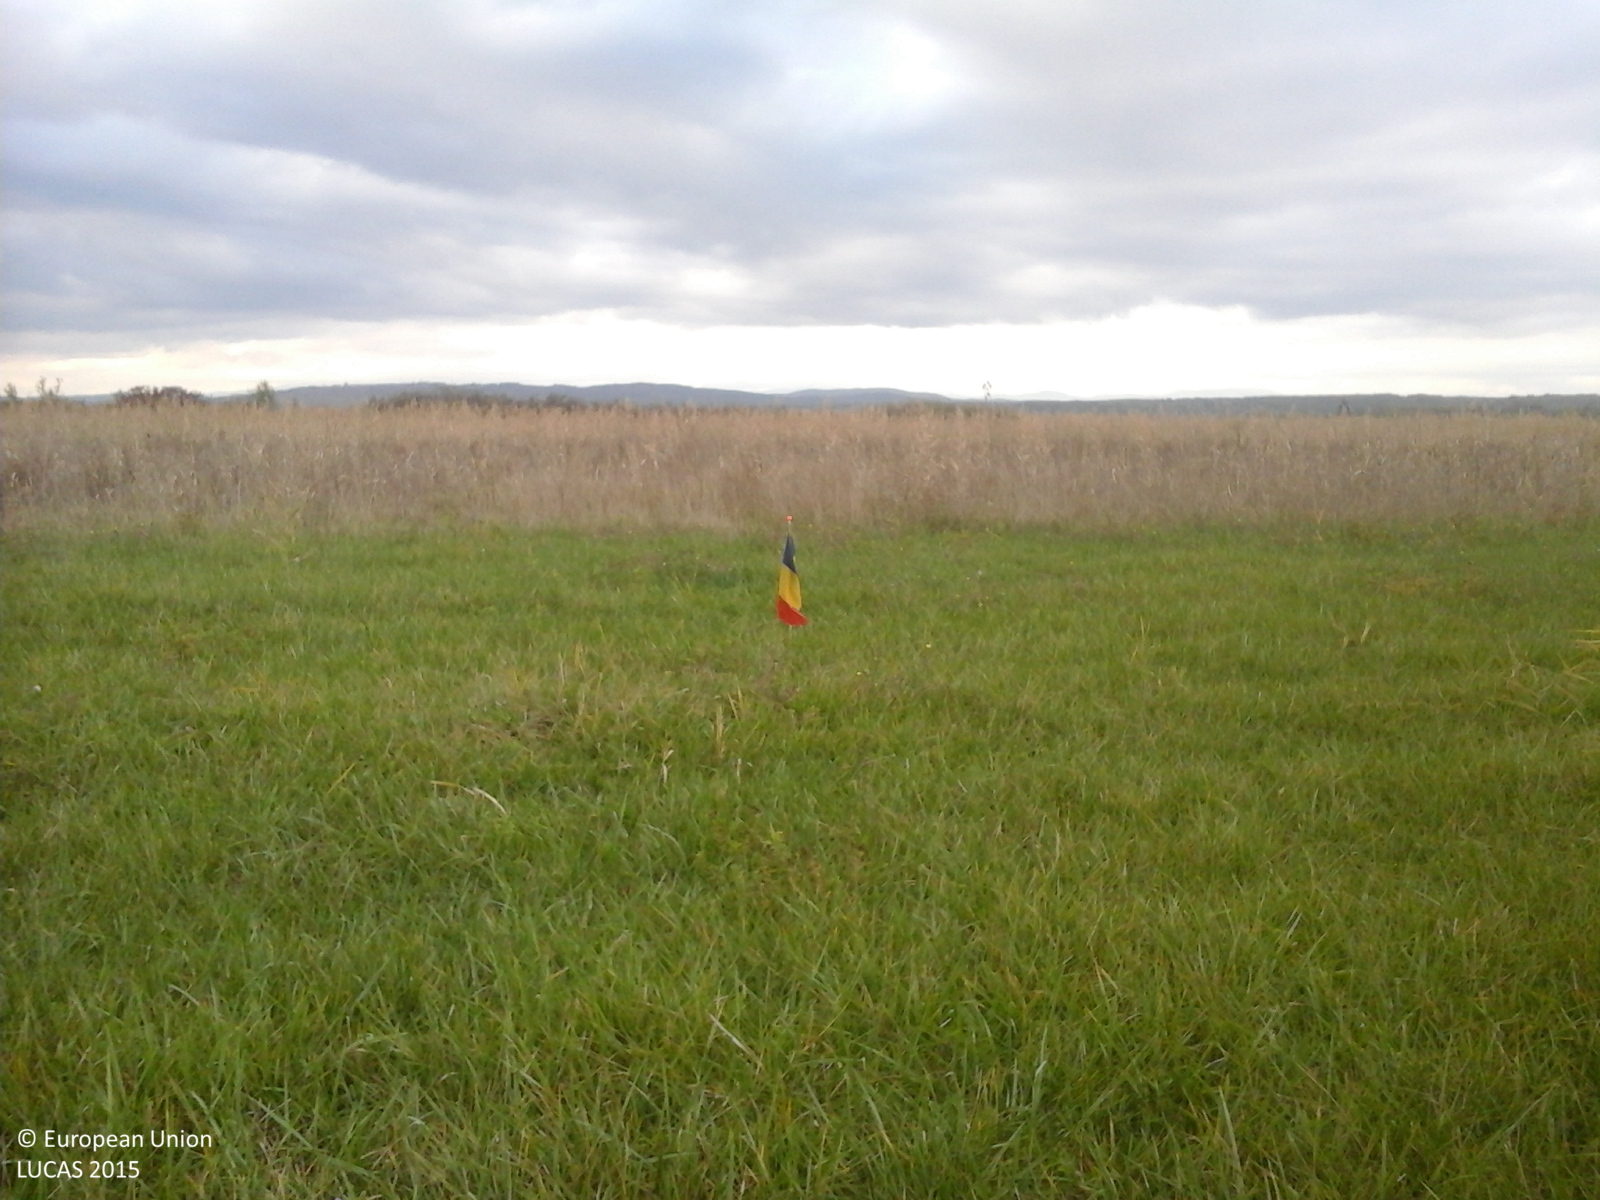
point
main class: Grassland
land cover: Grassland without tree/shrub cover
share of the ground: > 75 %
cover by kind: herbaceous plants 100 %
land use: Agriculture (excluding fallow land and kitchen gardens)
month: October
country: RO
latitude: 44.9025
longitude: 25.6121
